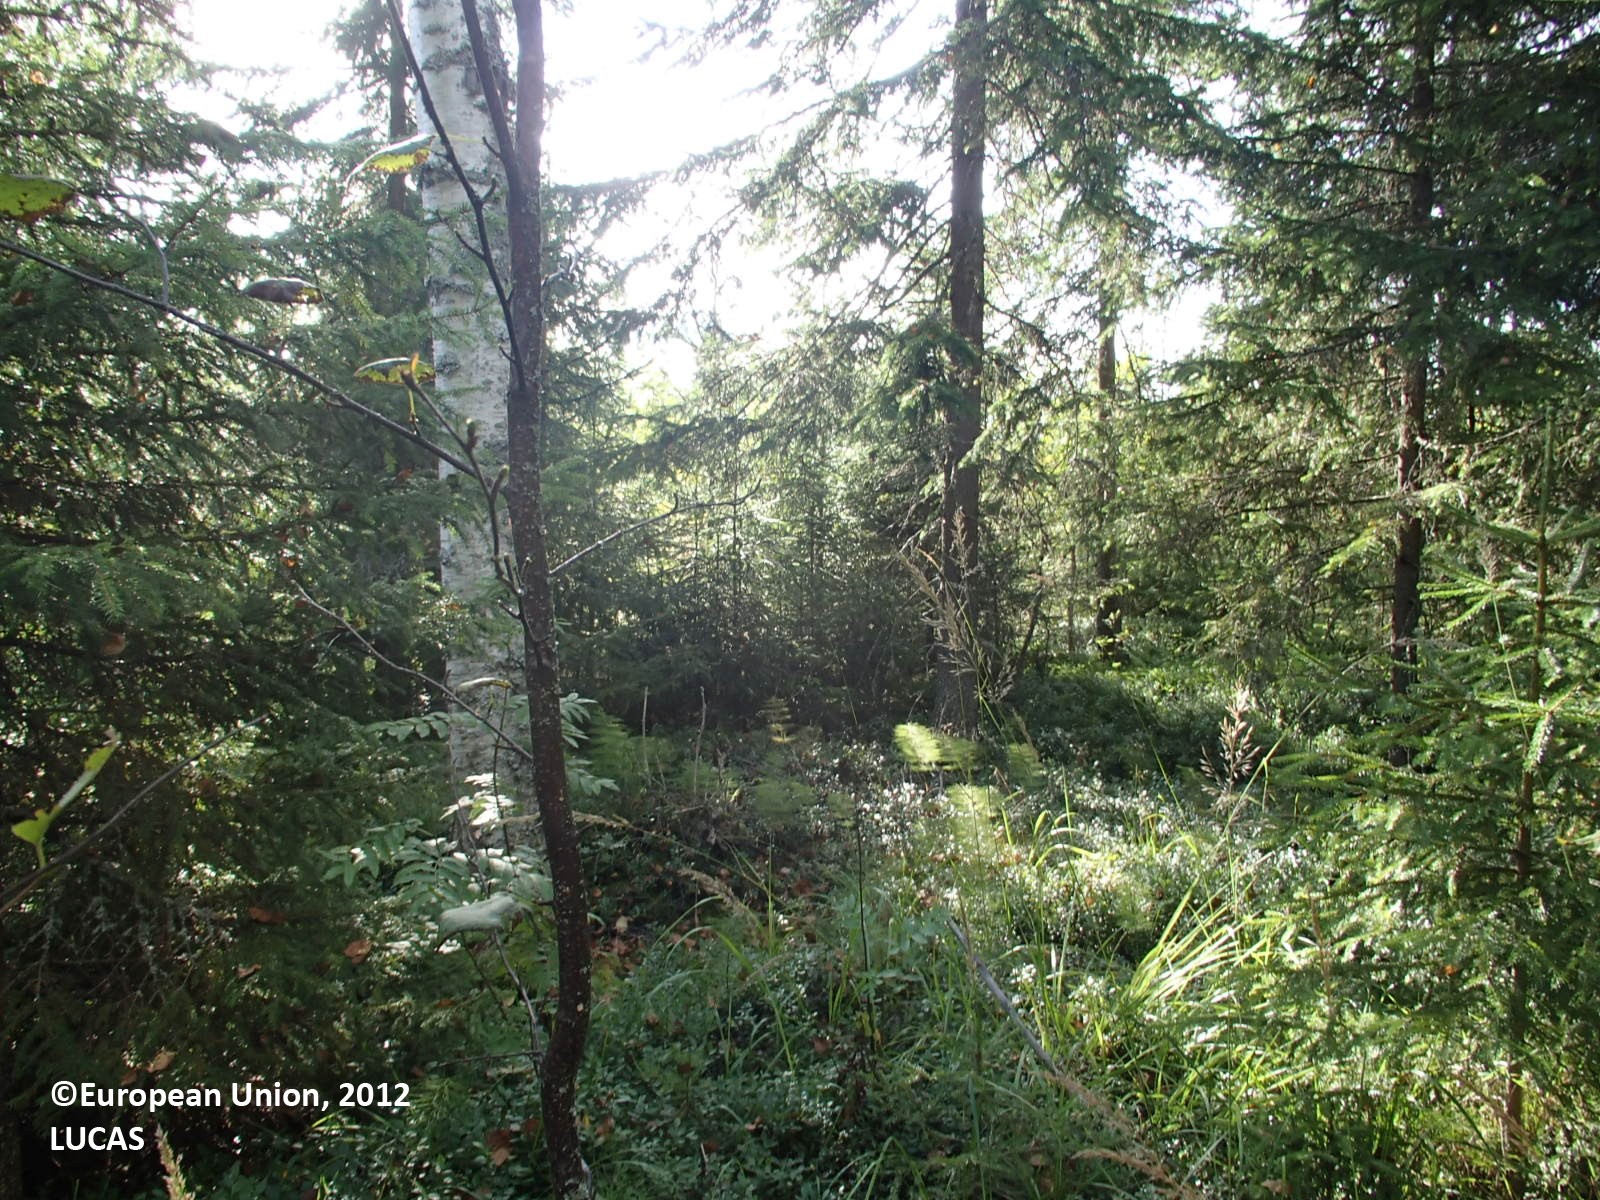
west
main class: Woodland
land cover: Spruce dominated mixed woodland
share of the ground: > 75 %
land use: Forestry
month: August
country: FI
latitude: 63.4571
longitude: 27.9210
